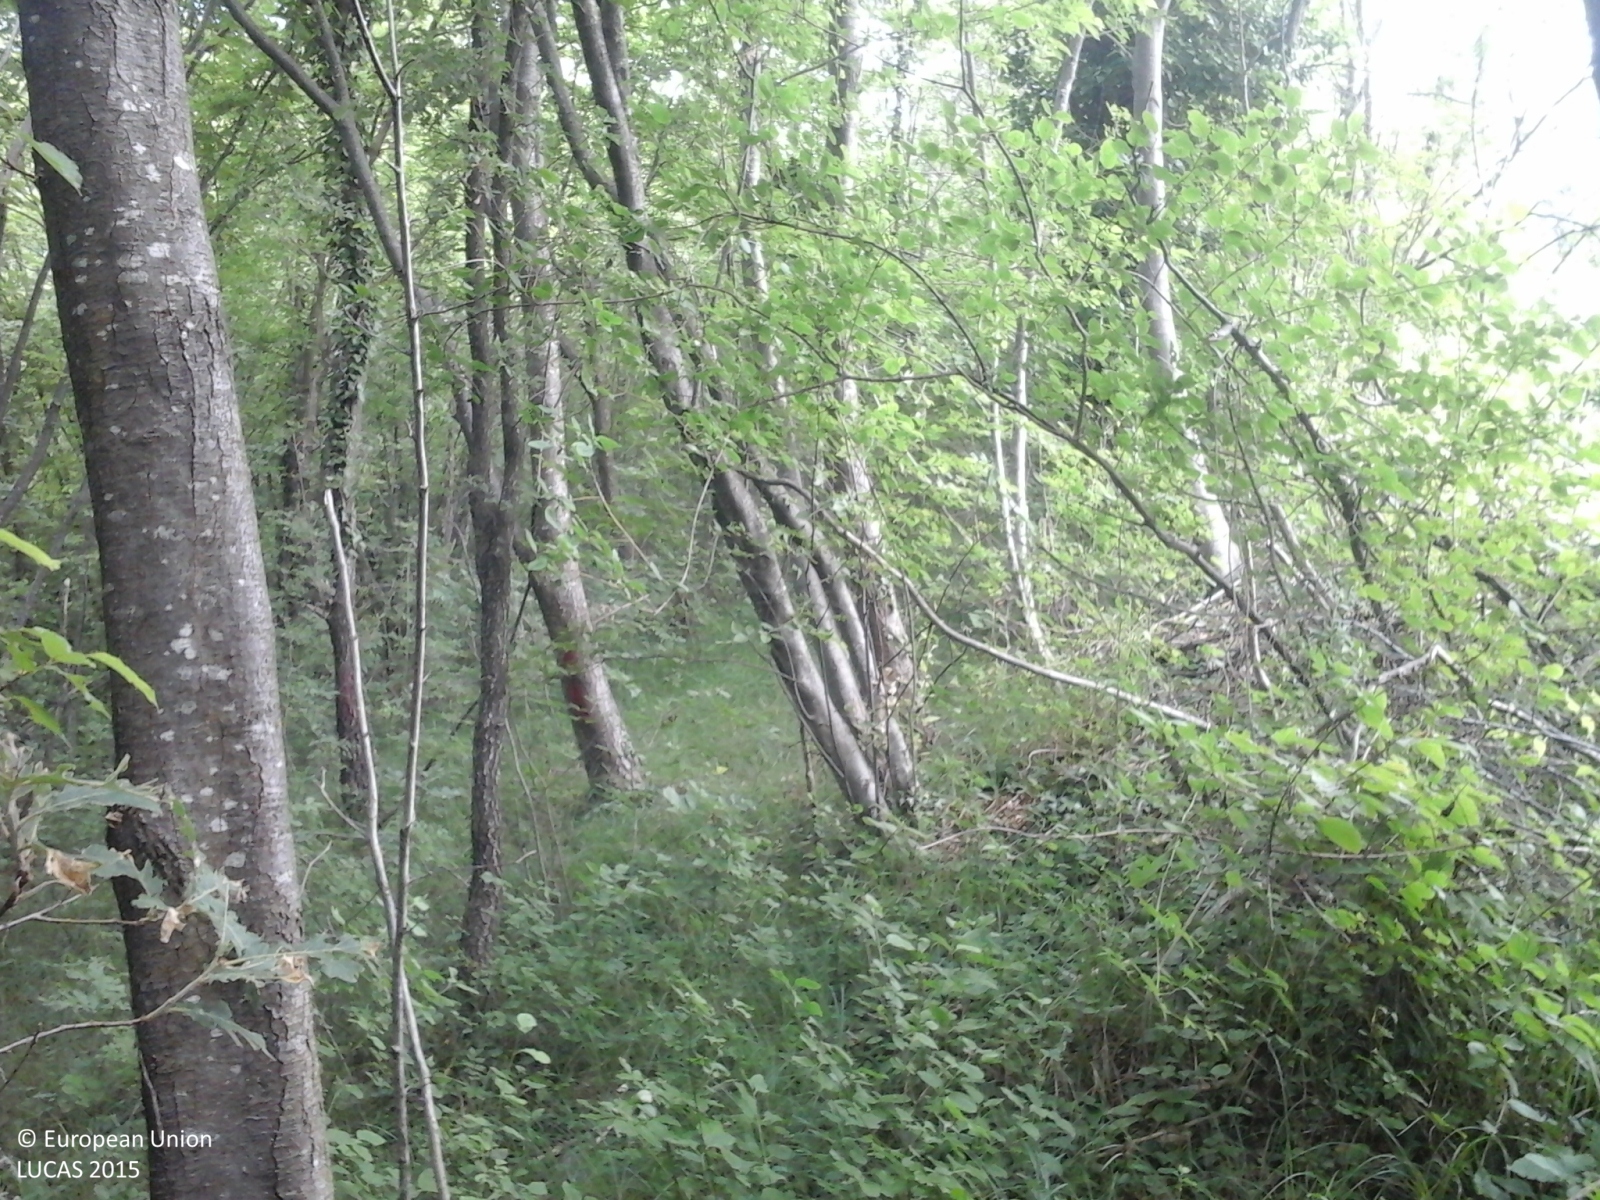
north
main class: Woodland
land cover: Broadleaved woodland
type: thermophilous deciduous forest
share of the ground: > 75 %
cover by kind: broadleaved forest trees 100 %
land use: Forestry
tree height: > 5 m
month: June
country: IT
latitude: 45.7817
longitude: 11.5283
